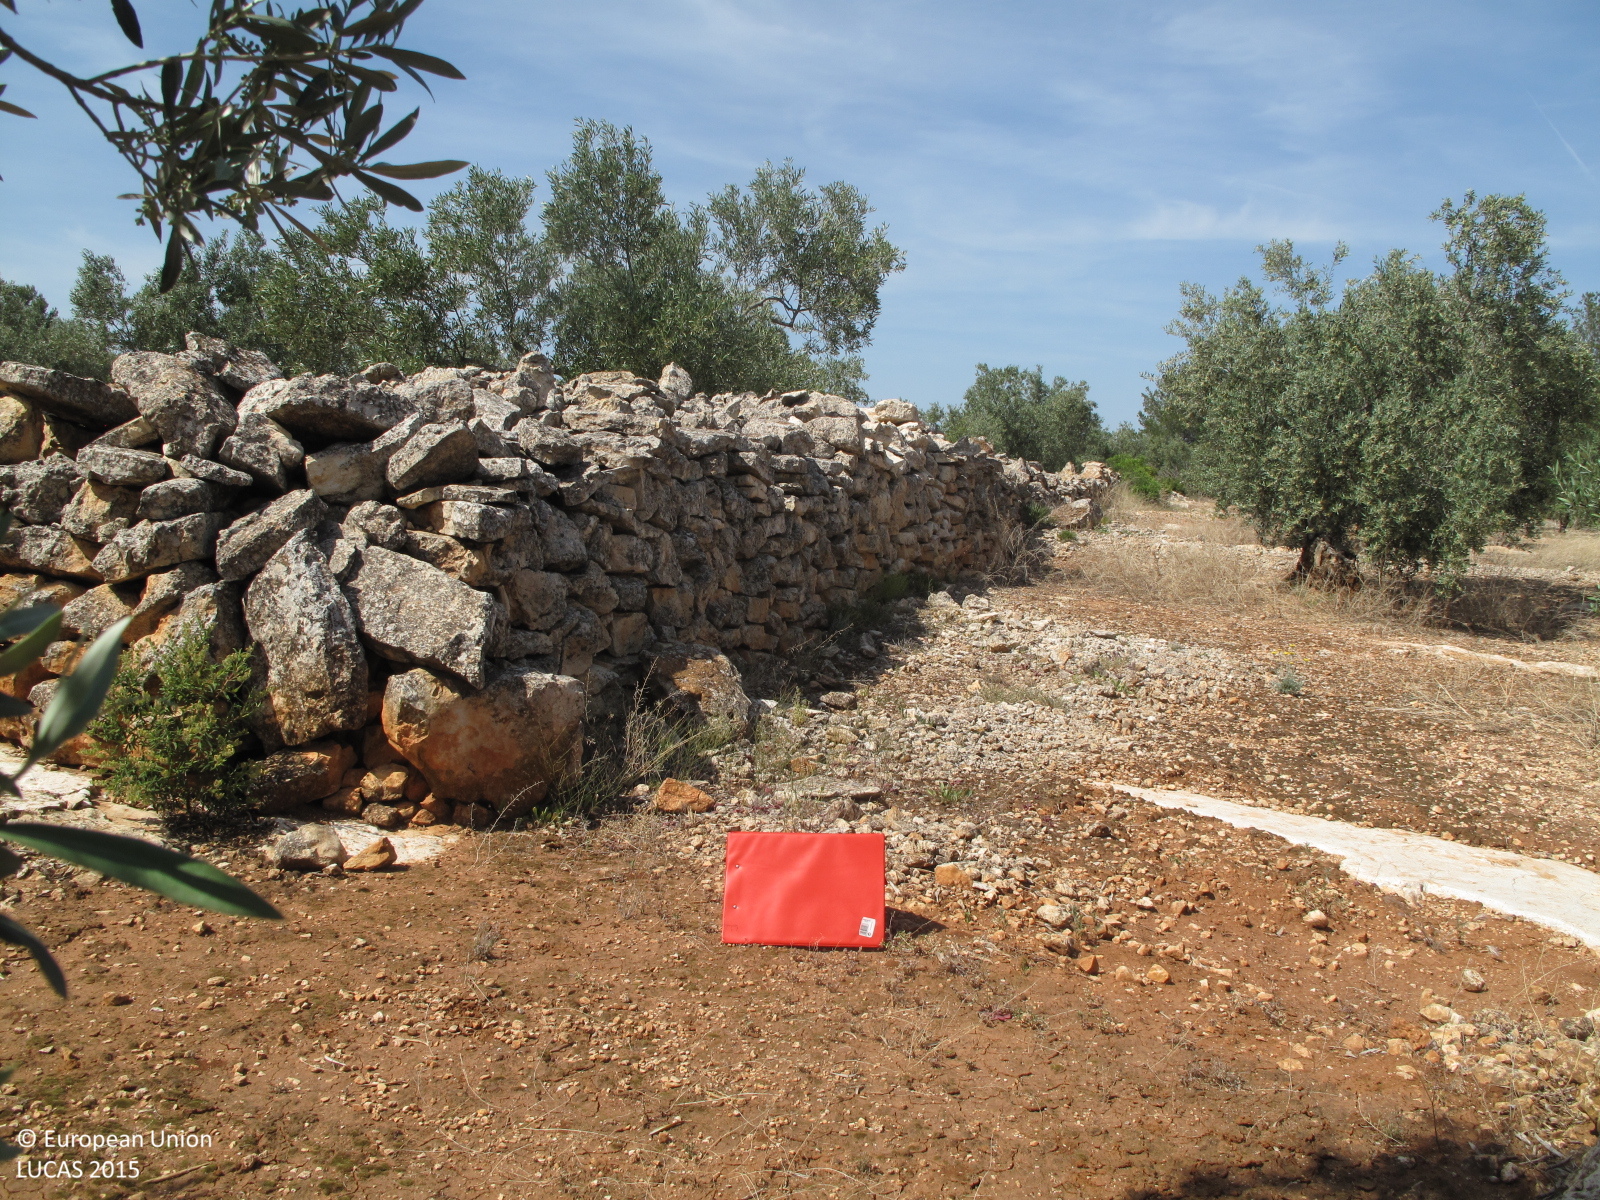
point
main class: Cropland
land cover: Olive groves
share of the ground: 10 - 25 %
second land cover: Spontaneously vegetated surfaces
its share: 25 - 50 %
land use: Agriculture (excluding fallow land and kitchen gardens)
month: May
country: ES
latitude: 38.9825
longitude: -0.7410
